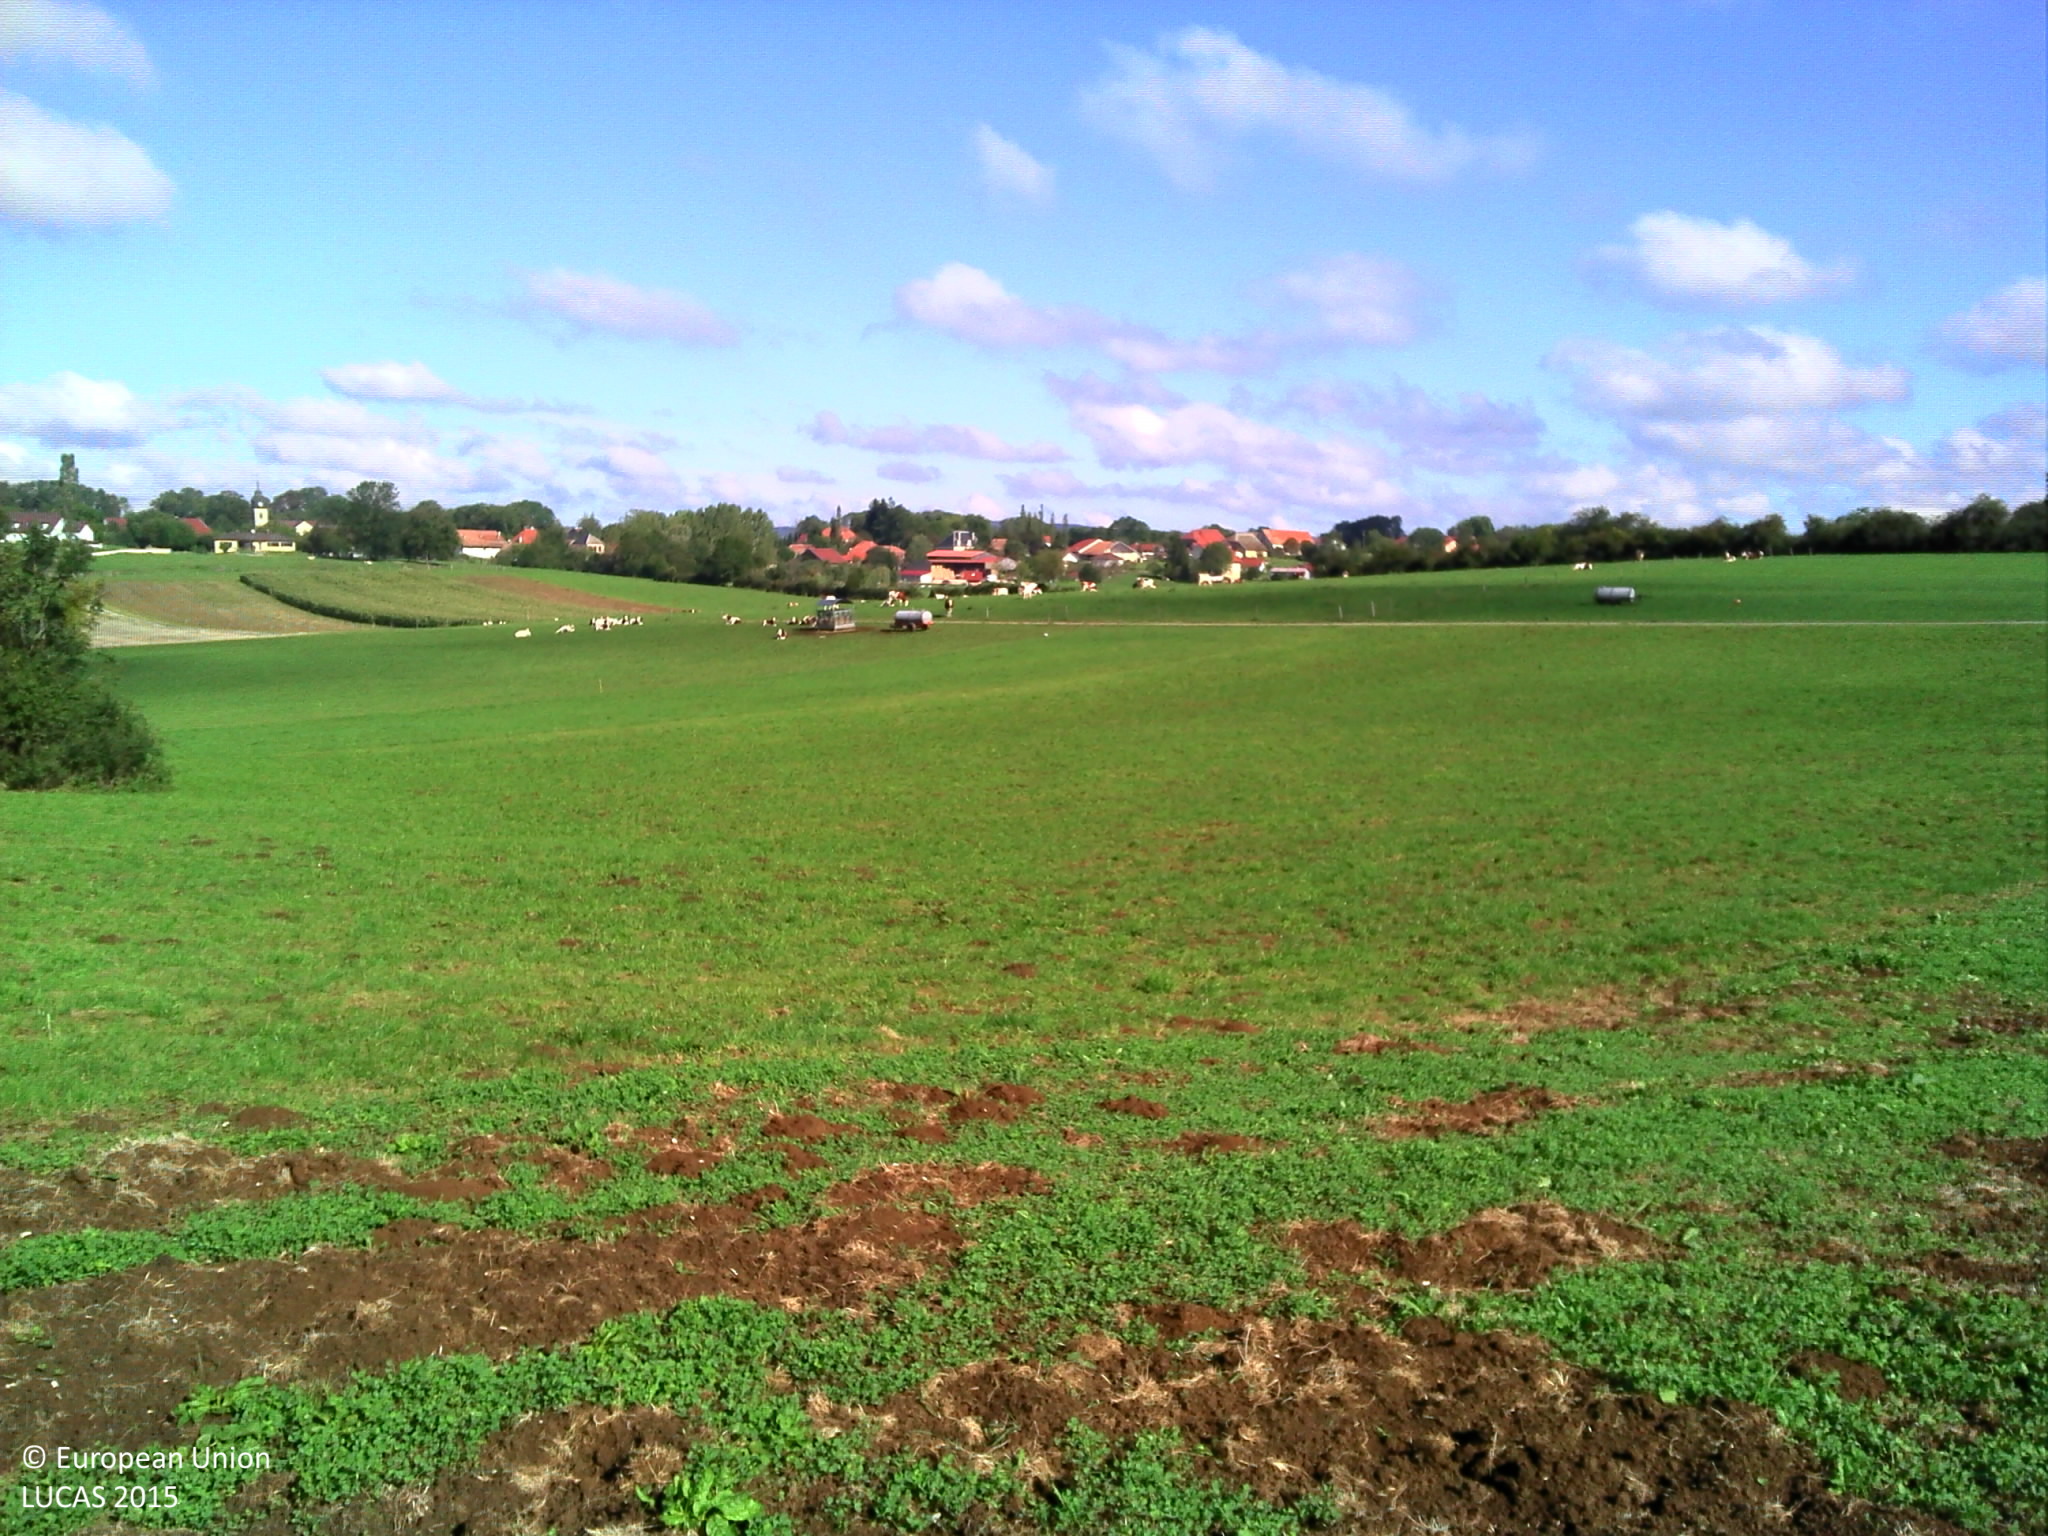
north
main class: Grassland
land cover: Spontaneously vegetated surfaces
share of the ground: > 75 %
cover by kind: herbaceous plants 95 %, shrubs 5 %
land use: Agriculture (excluding fallow land and kitchen gardens)
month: September
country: FR
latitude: 47.1146
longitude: 6.2460
